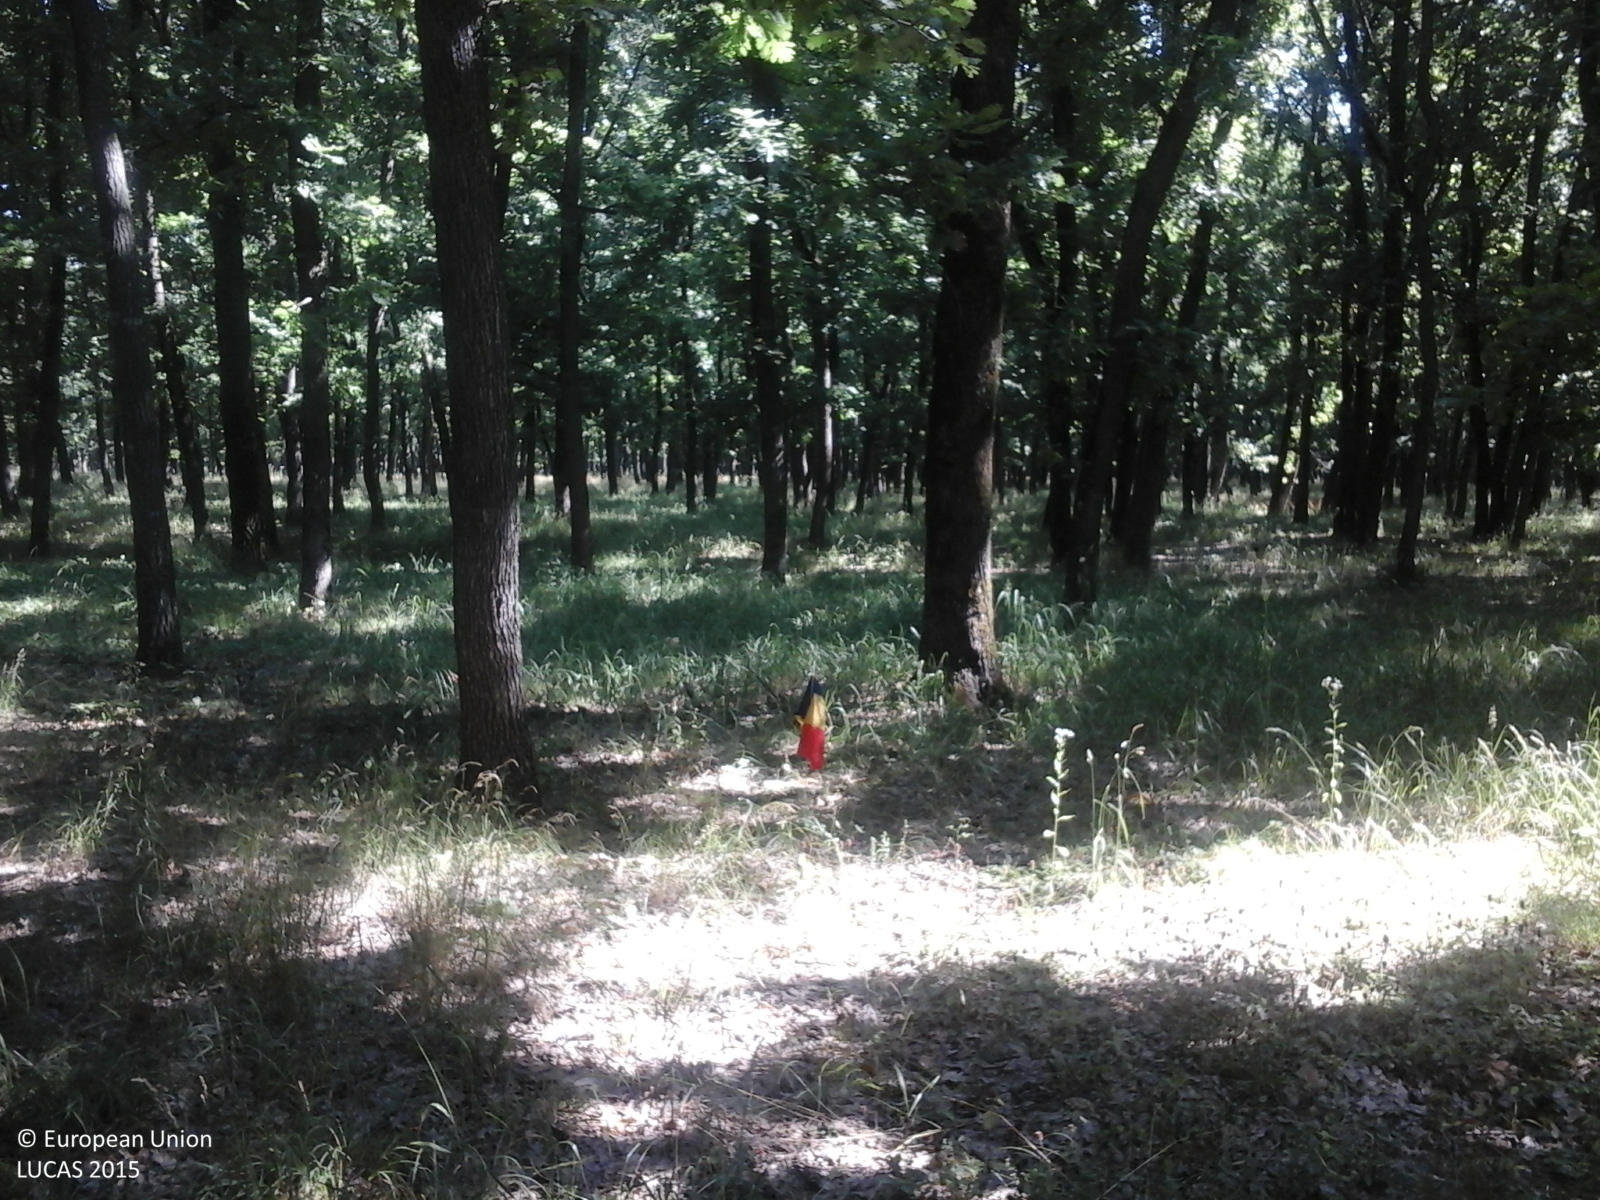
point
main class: Woodland
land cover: Broadleaved woodland
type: thermophilous deciduous forest
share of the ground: > 75 %
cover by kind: broadleaved forest trees 100 %
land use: Forestry
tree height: > 5 m
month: July
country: RO
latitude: 44.4539
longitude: 24.1519
